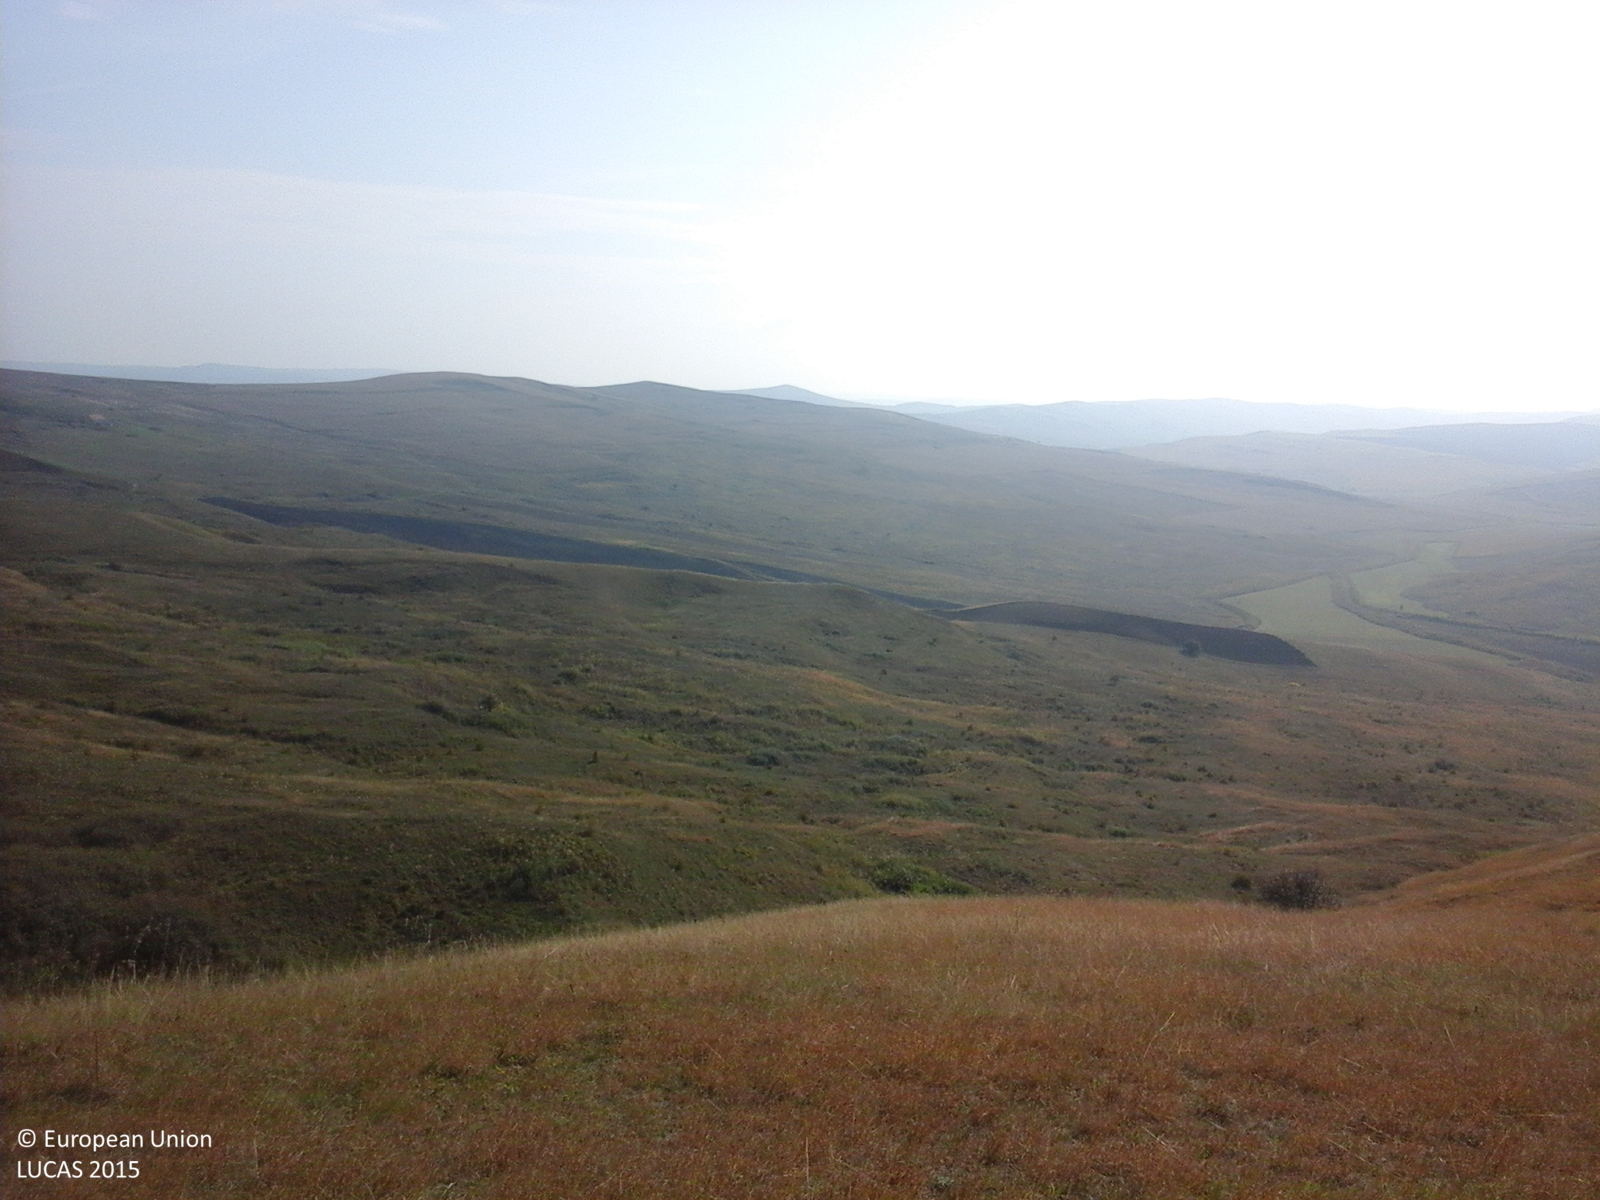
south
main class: Grassland
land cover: Grassland without tree/shrub cover
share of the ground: > 75 %
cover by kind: herbaceous plants 100 %
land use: Agriculture (excluding fallow land and kitchen gardens)
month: October
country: RO
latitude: 46.2935
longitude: 23.9250
